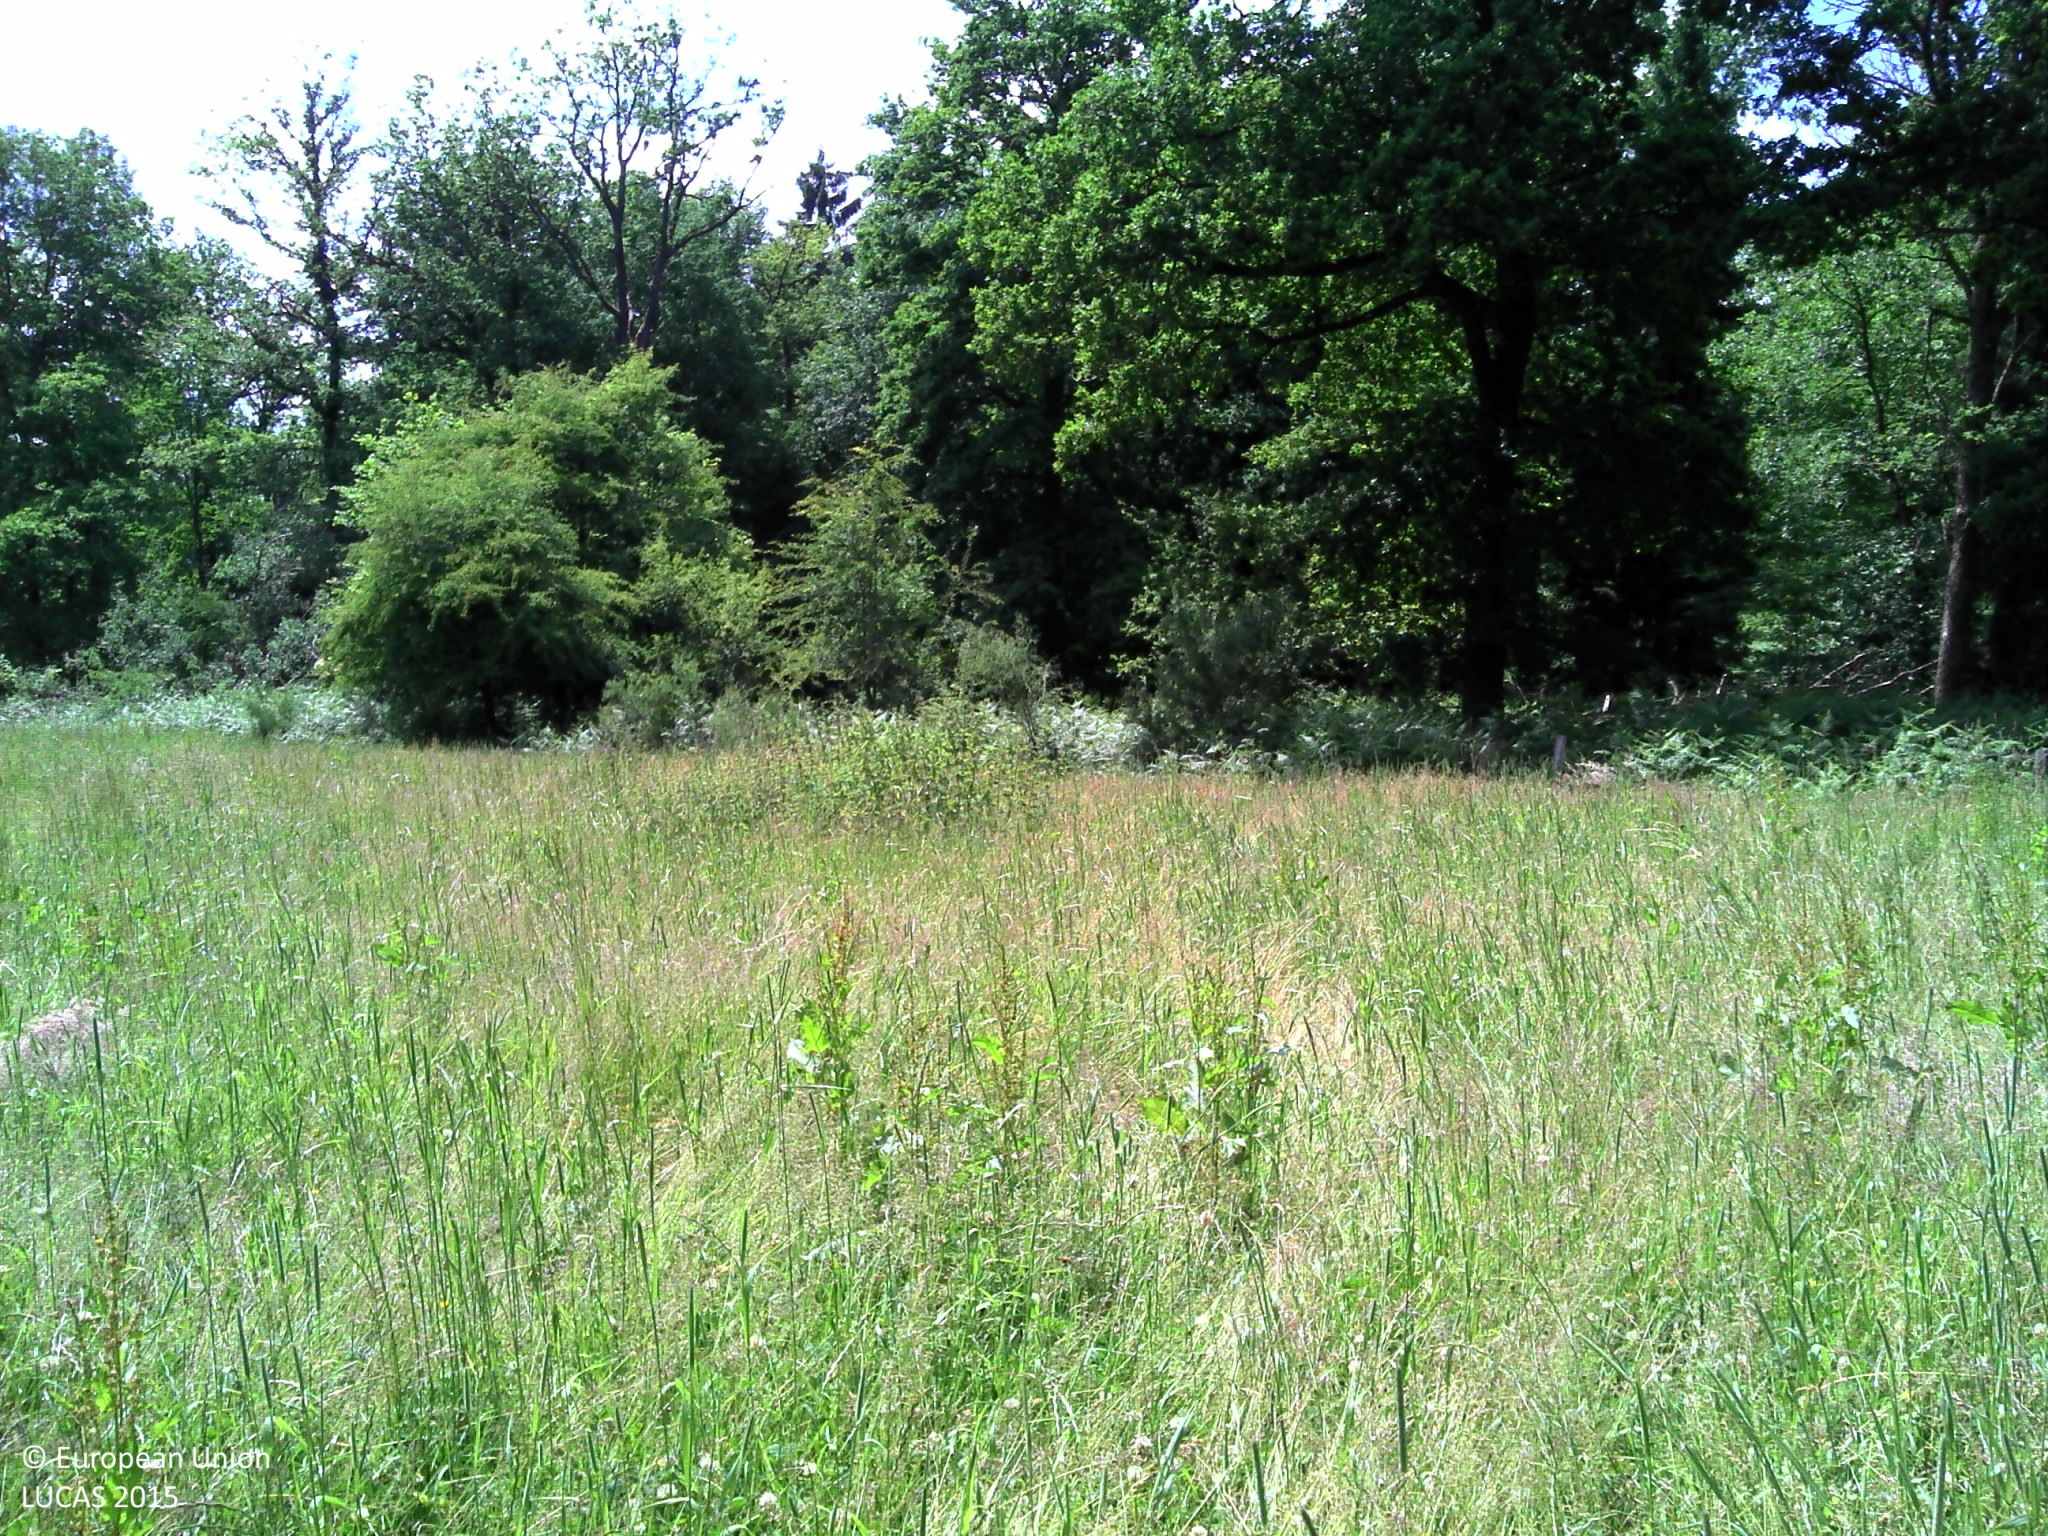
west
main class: Woodland
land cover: Broadleaved woodland
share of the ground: > 75 %
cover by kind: broadleaved forest trees 90 %, herbaceous plants 10 %
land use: Forestry
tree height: > 5 m
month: June
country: BE
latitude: 50.0104
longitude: 5.1835
